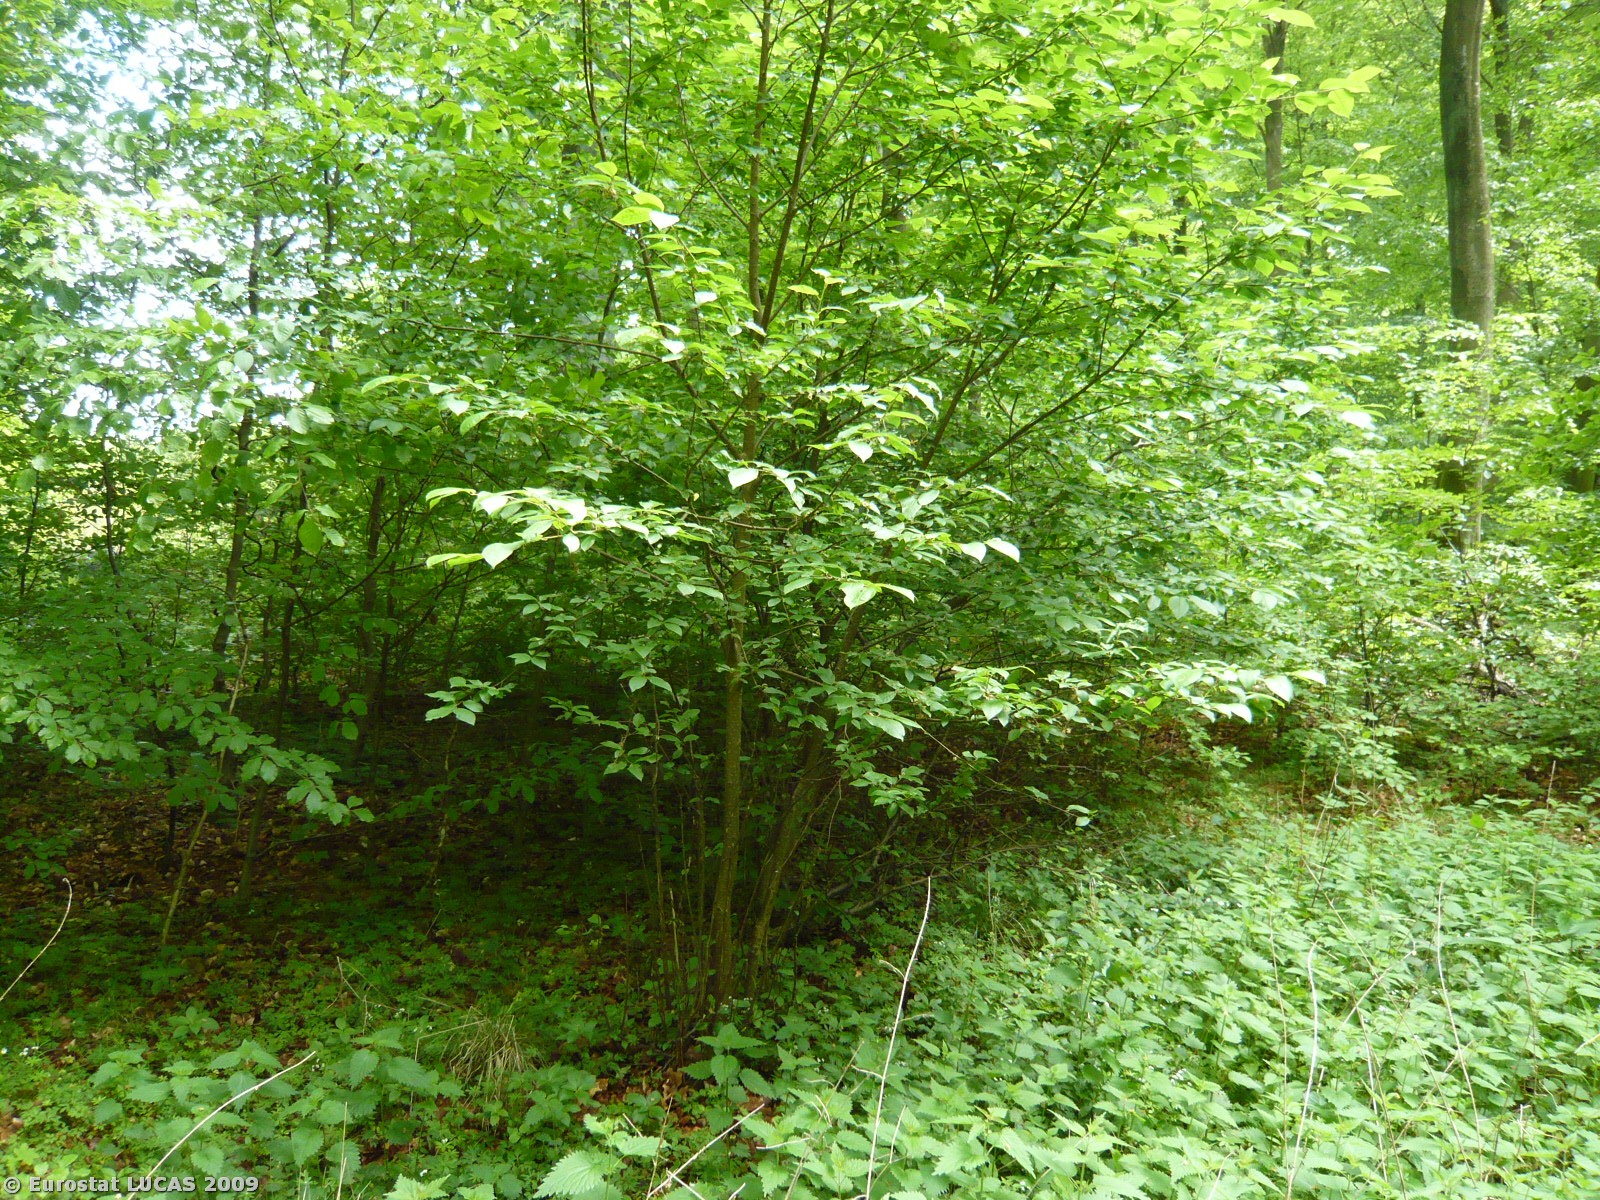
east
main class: Woodland
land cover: Broadleaved woodland
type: mesophytic deciduous forest
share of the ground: > 75 %
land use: Forestry
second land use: Amenities, museums, leisure
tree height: > 5 m
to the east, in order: Broadleaved woodland
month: May
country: DK
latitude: 55.4228
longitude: 11.5944
